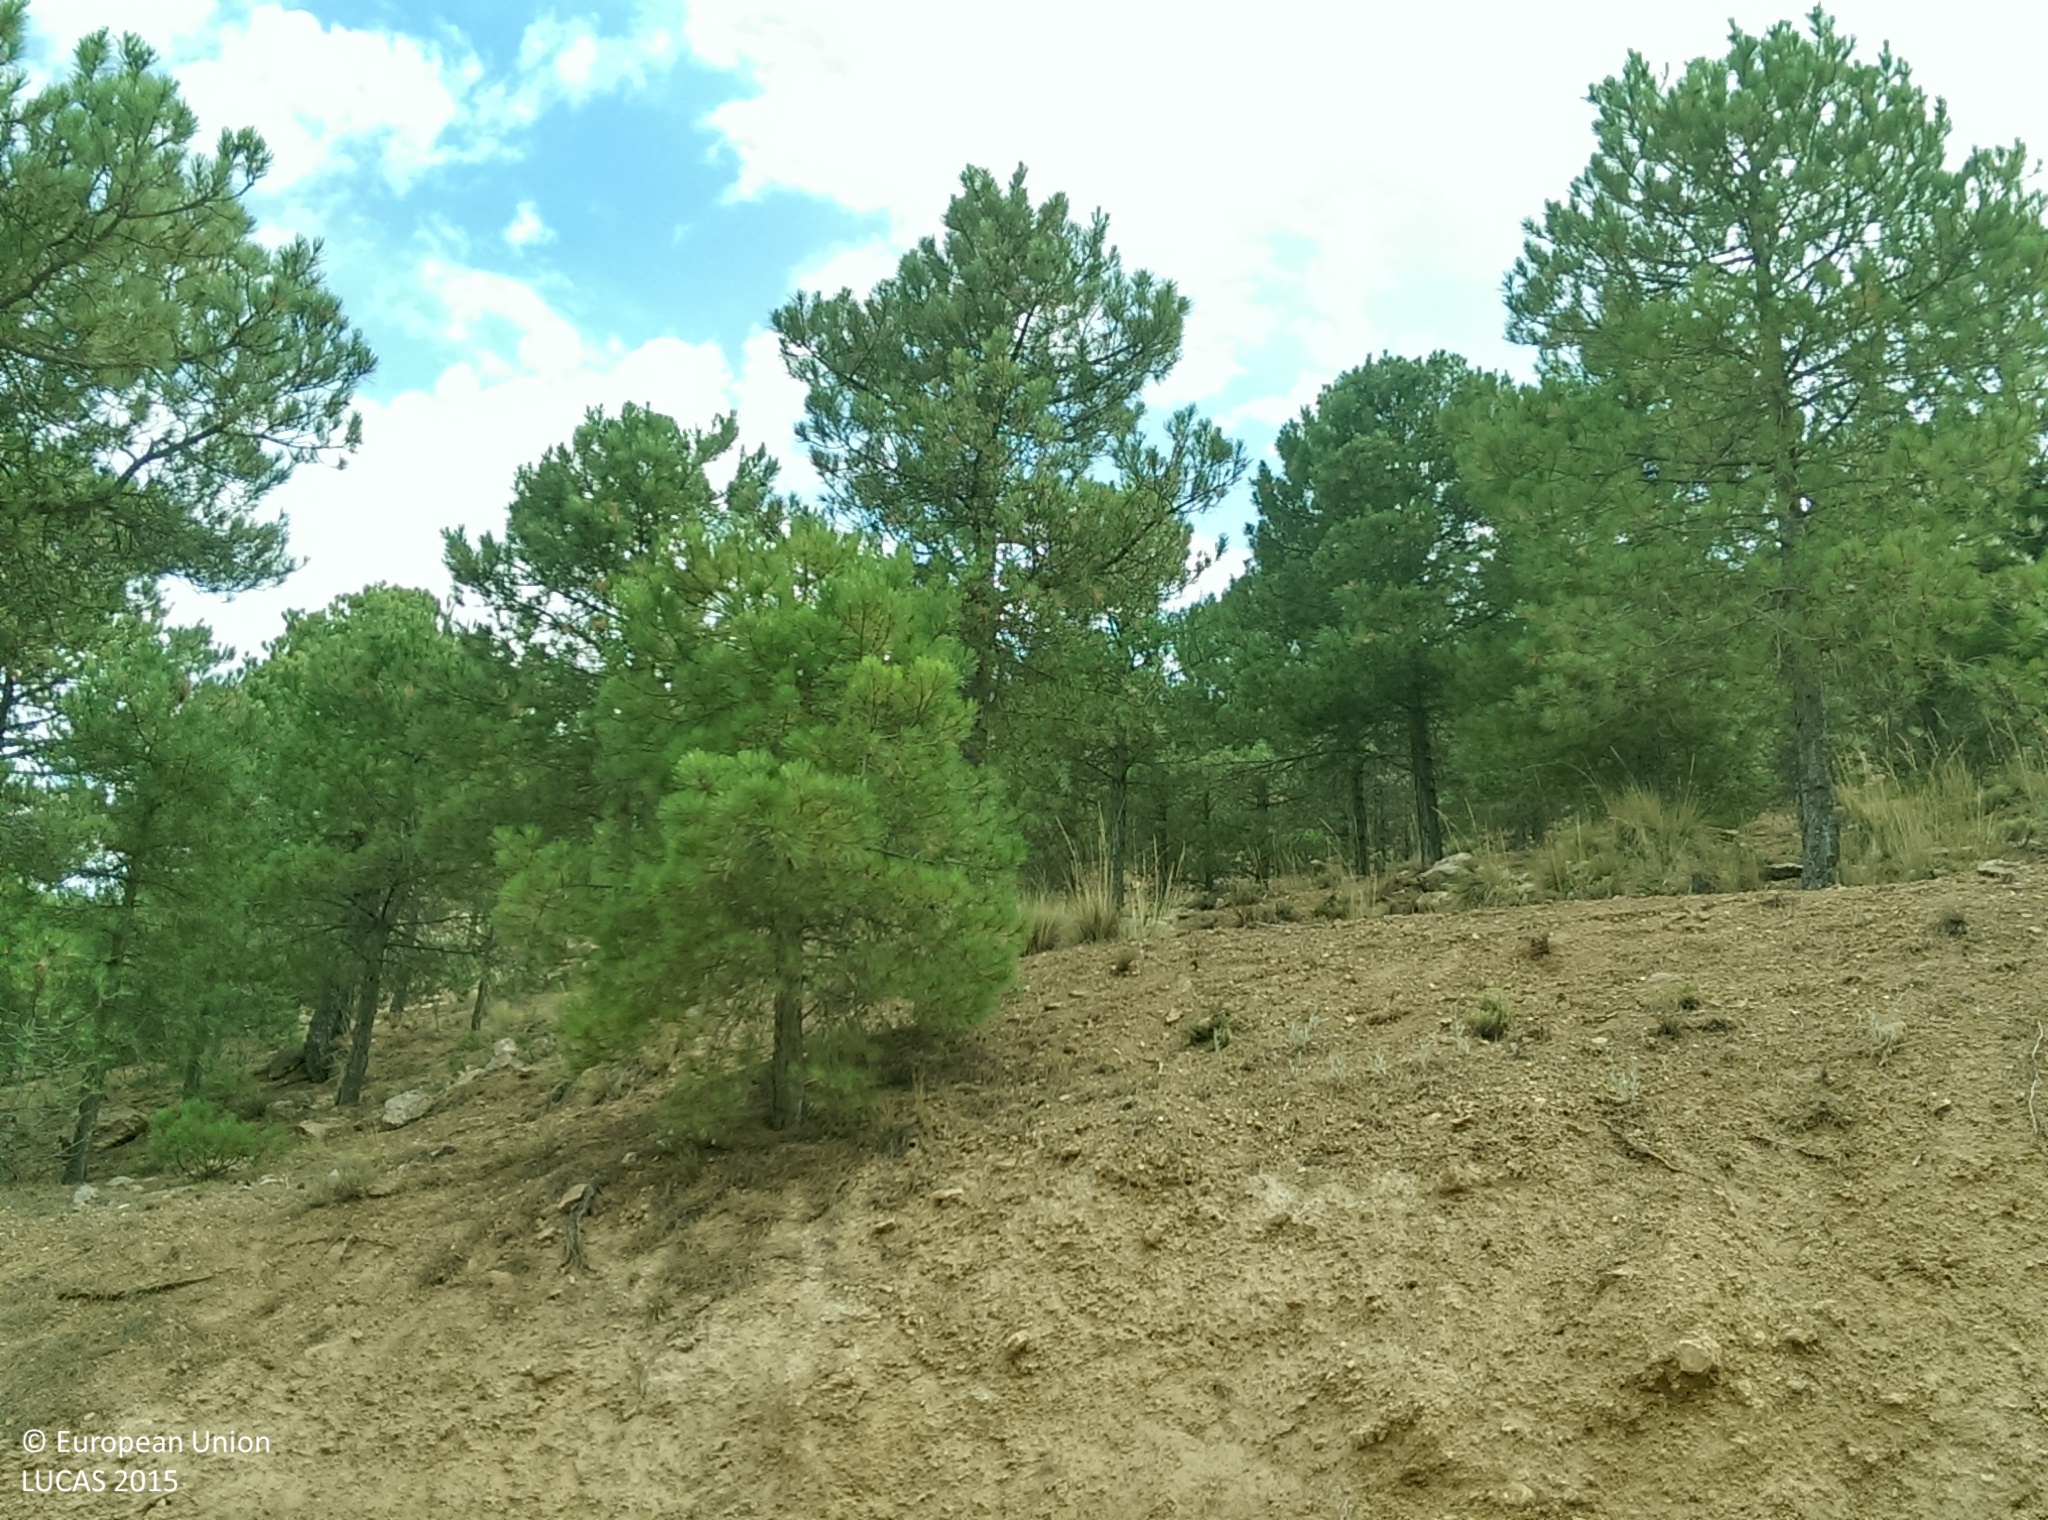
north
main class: Woodland
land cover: Pine dominated coniferous woodland
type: coniferous forest of the mediterranean region
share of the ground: 10 - 25 %
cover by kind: shrubs 40 %, herbaceous plants 20 %, coniferous forest trees 15 %, consolidated bare surface 15 %, unconsolidated bare surface 10 %
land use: Forestry
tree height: > 5 m
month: July
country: ES
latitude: 37.3077
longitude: -2.8812
